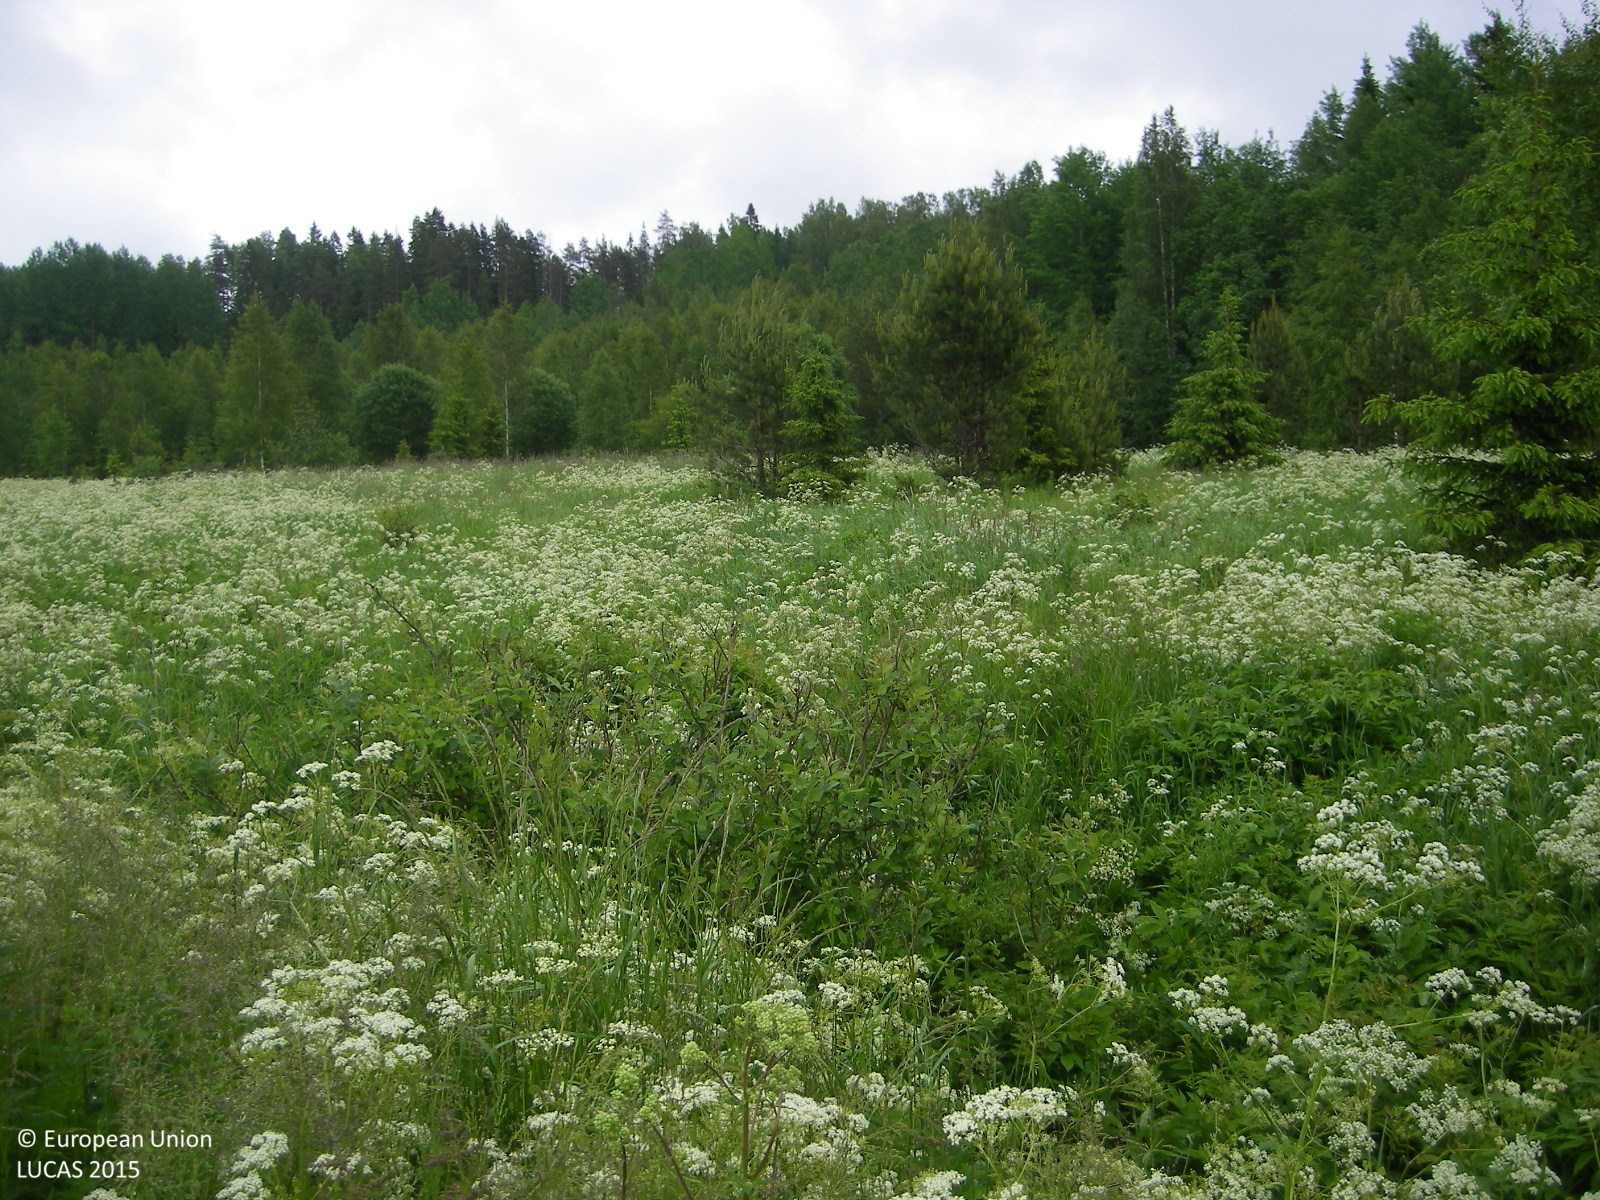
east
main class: Cropland
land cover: Common wheat
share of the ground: > 75 %
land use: Agriculture (excluding fallow land and kitchen gardens)
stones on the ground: < 10 %
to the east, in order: Common wheat; Ditches and canals; Grassland without tree/shrub cover; Ditches and canals; Grassland without tree/shrub cover; Ditches and canals; Grassland with sparse tree/shrub cover; Ditches and canals; Broadleaved woodland; Abandoned hedges; Ditches and canals; Grassland without tree/shrub cover; Abandoned hedges; Grassland without tree/shrub cover; Ditches and canals; Broadleaved woodland; Ditches and canals; Broadleaved woodland; Tracks; Ditches and canals; Broadleaved woodland; Tracks; Broadleaved woodland
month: June
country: FI
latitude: 60.1463
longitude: 23.9103
